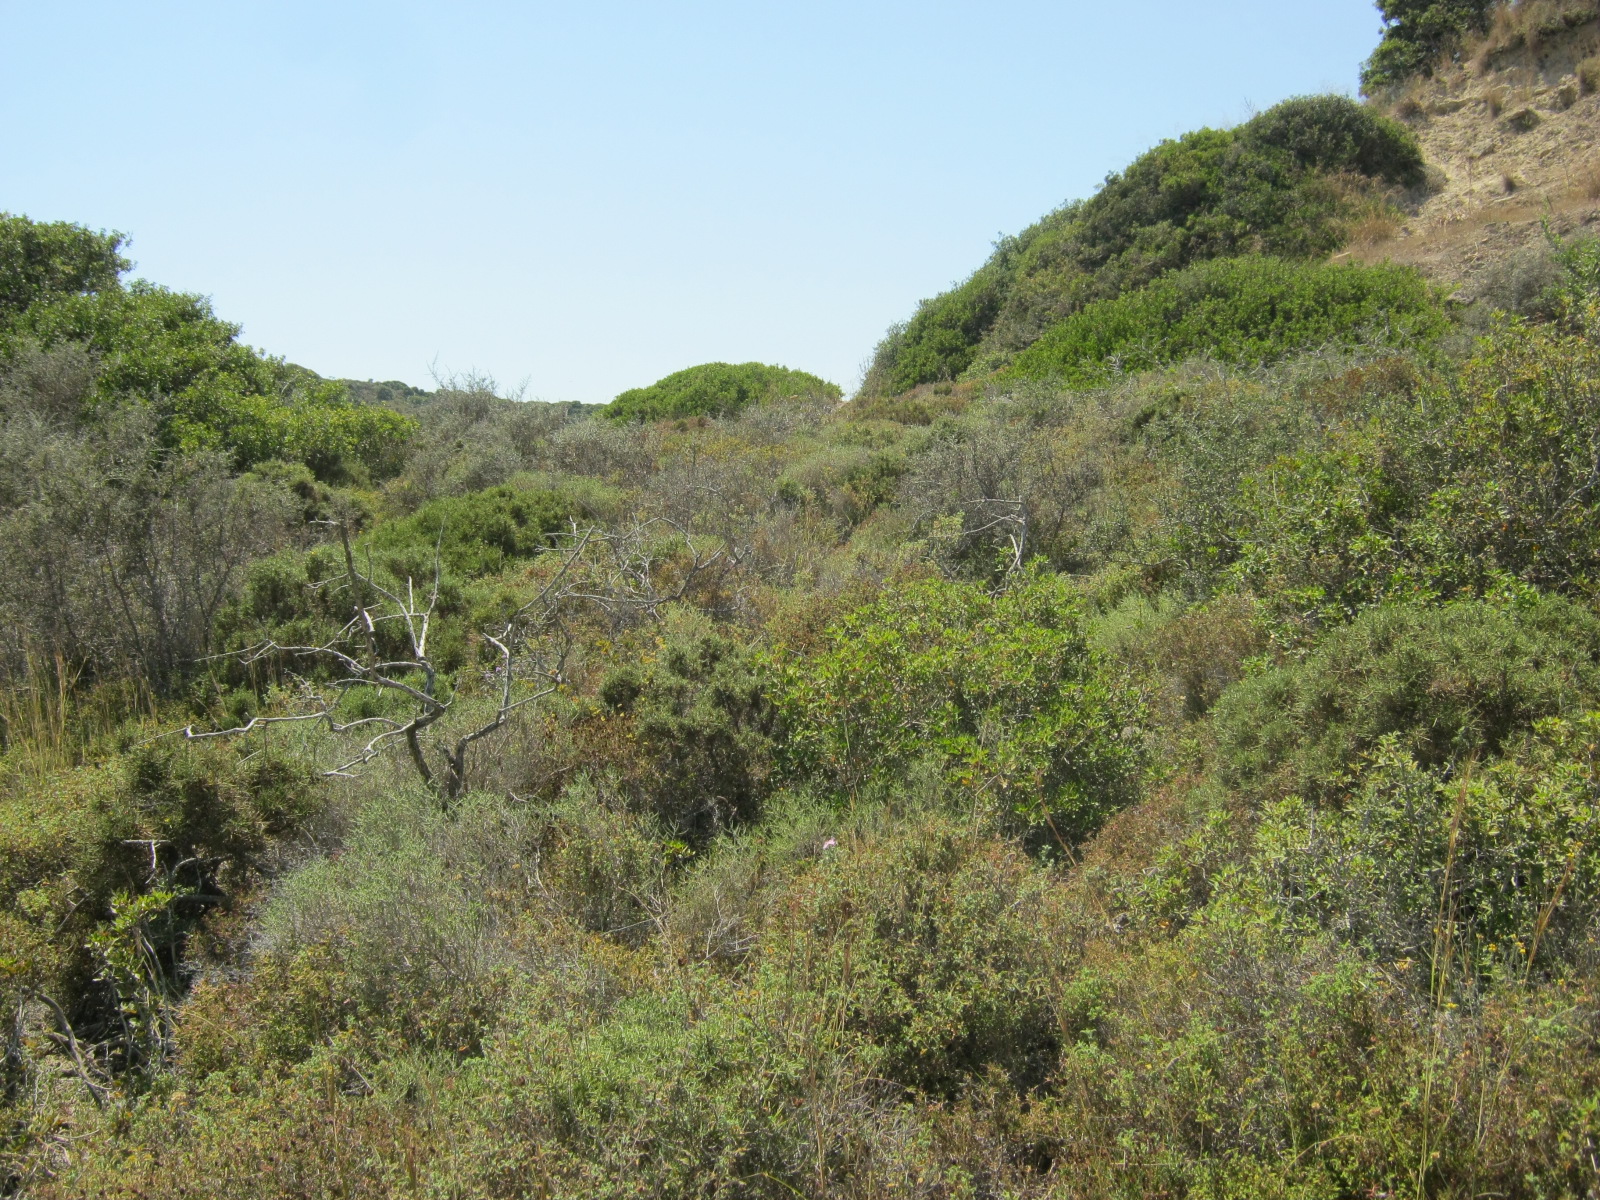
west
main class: Shrubland
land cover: Shrubland without tree cover
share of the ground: > 75 %
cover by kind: shrubs 100 %
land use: Semi-natural and natural areas not in use
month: June
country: GR
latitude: 36.7785
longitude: 27.0956
